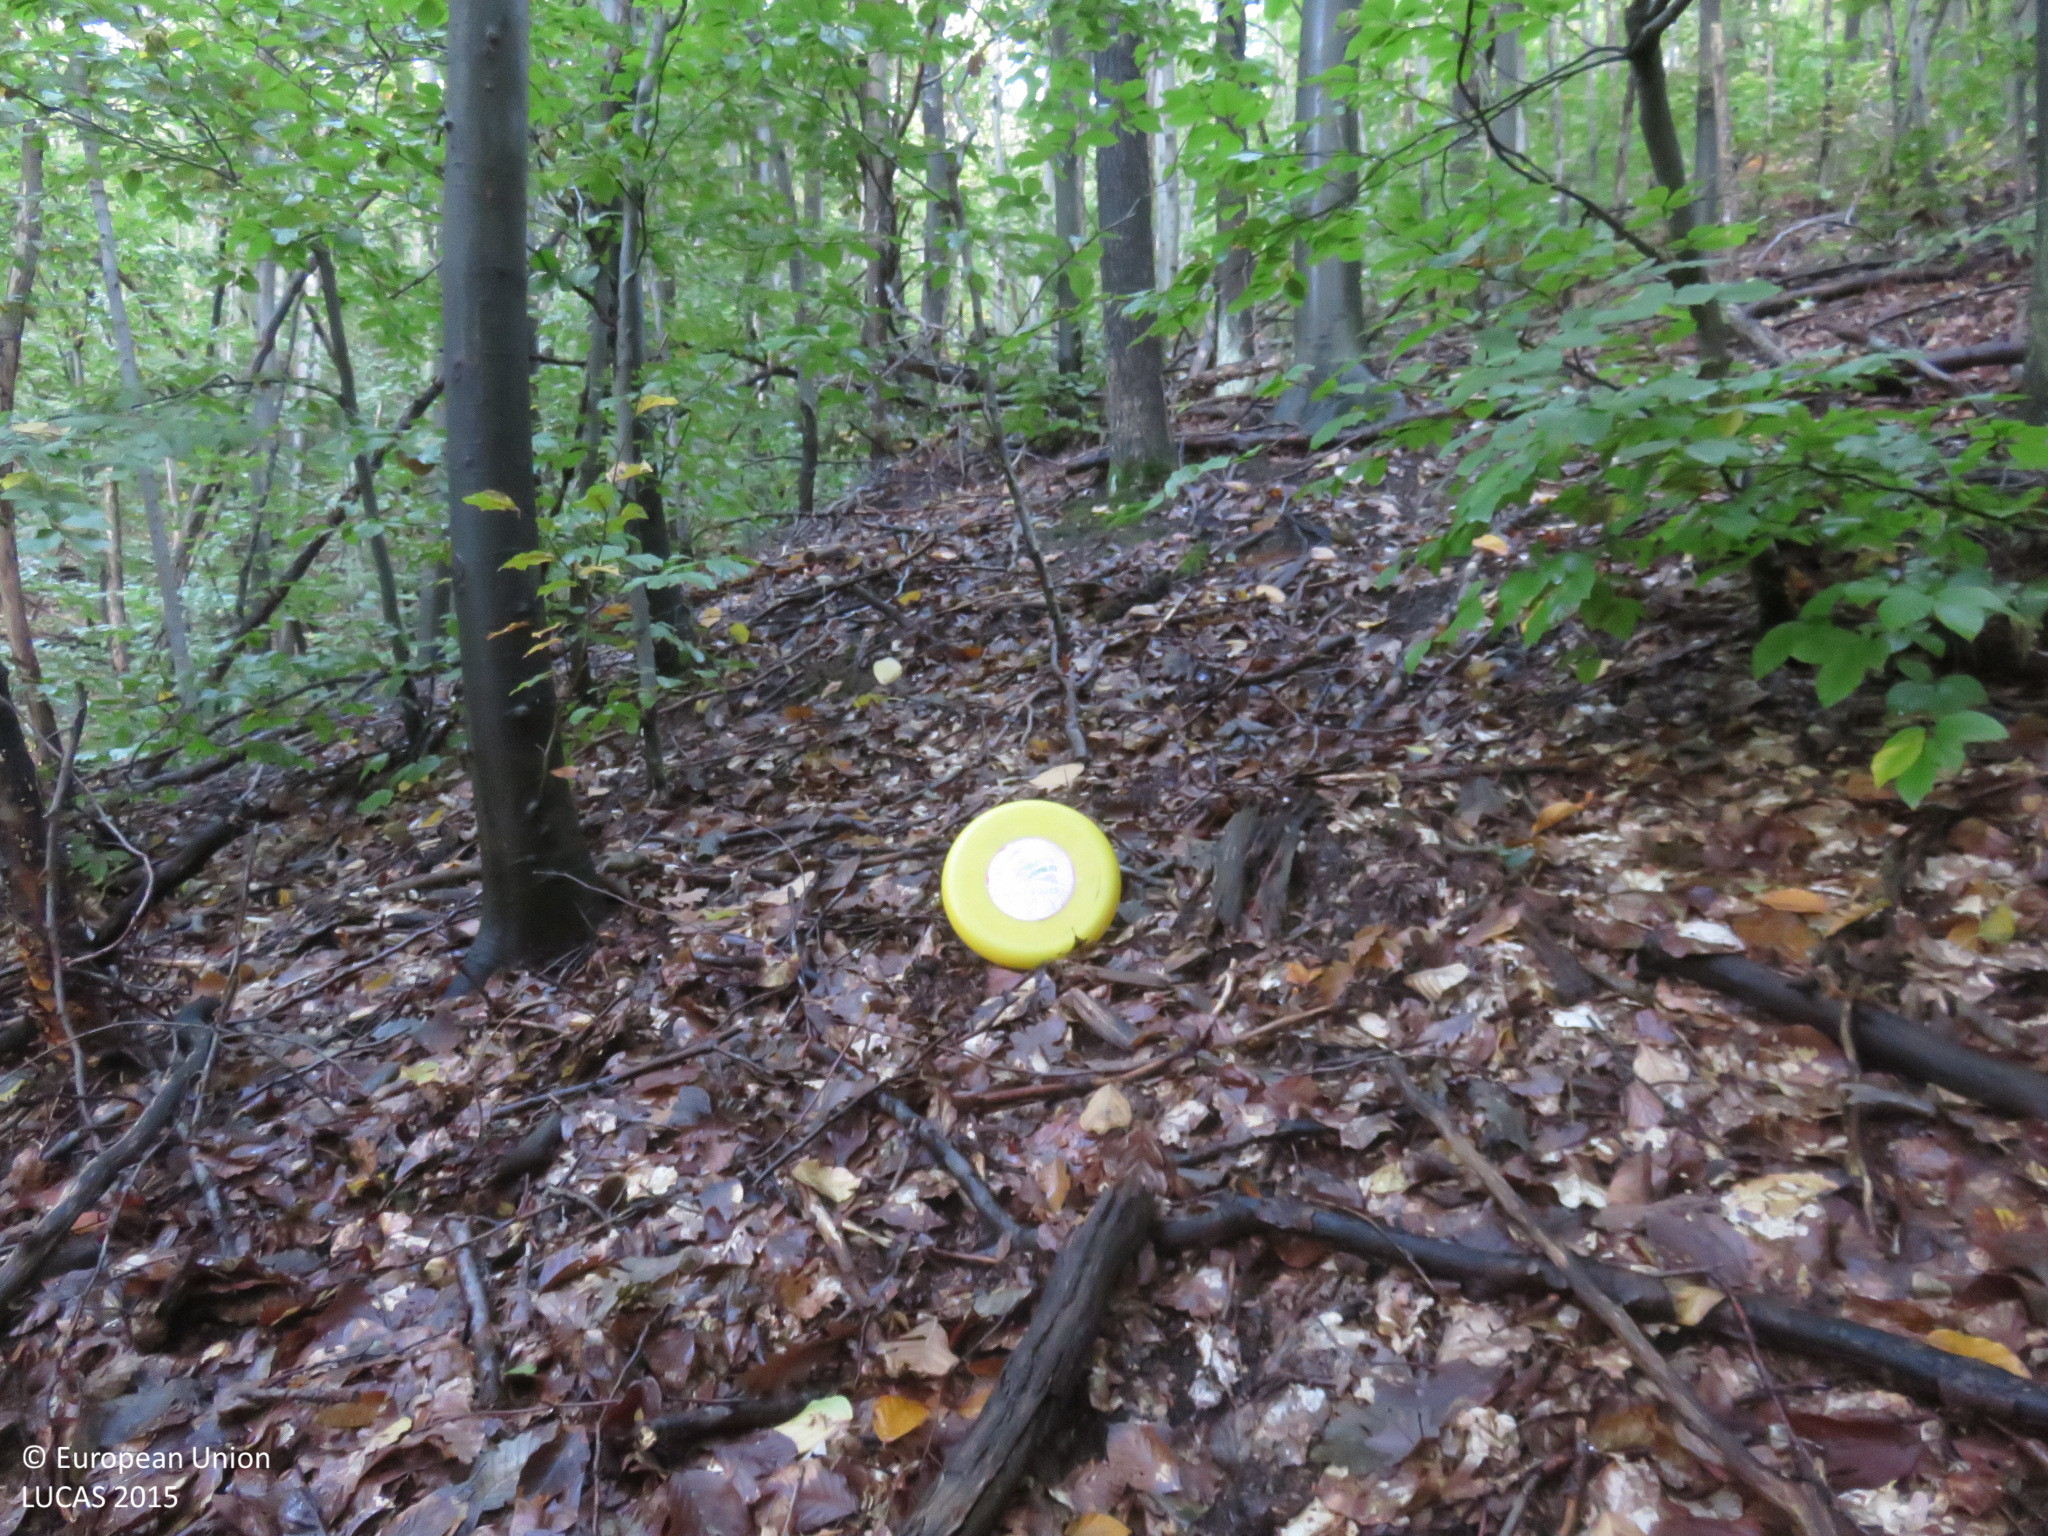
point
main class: Woodland
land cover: Broadleaved woodland
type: beech forest
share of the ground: > 75 %
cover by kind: broadleaved forest trees 95 %, unconsolidated bare surface 5 %
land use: Forestry
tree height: > 5 m
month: October
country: BG
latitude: 42.8437
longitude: 25.4036
